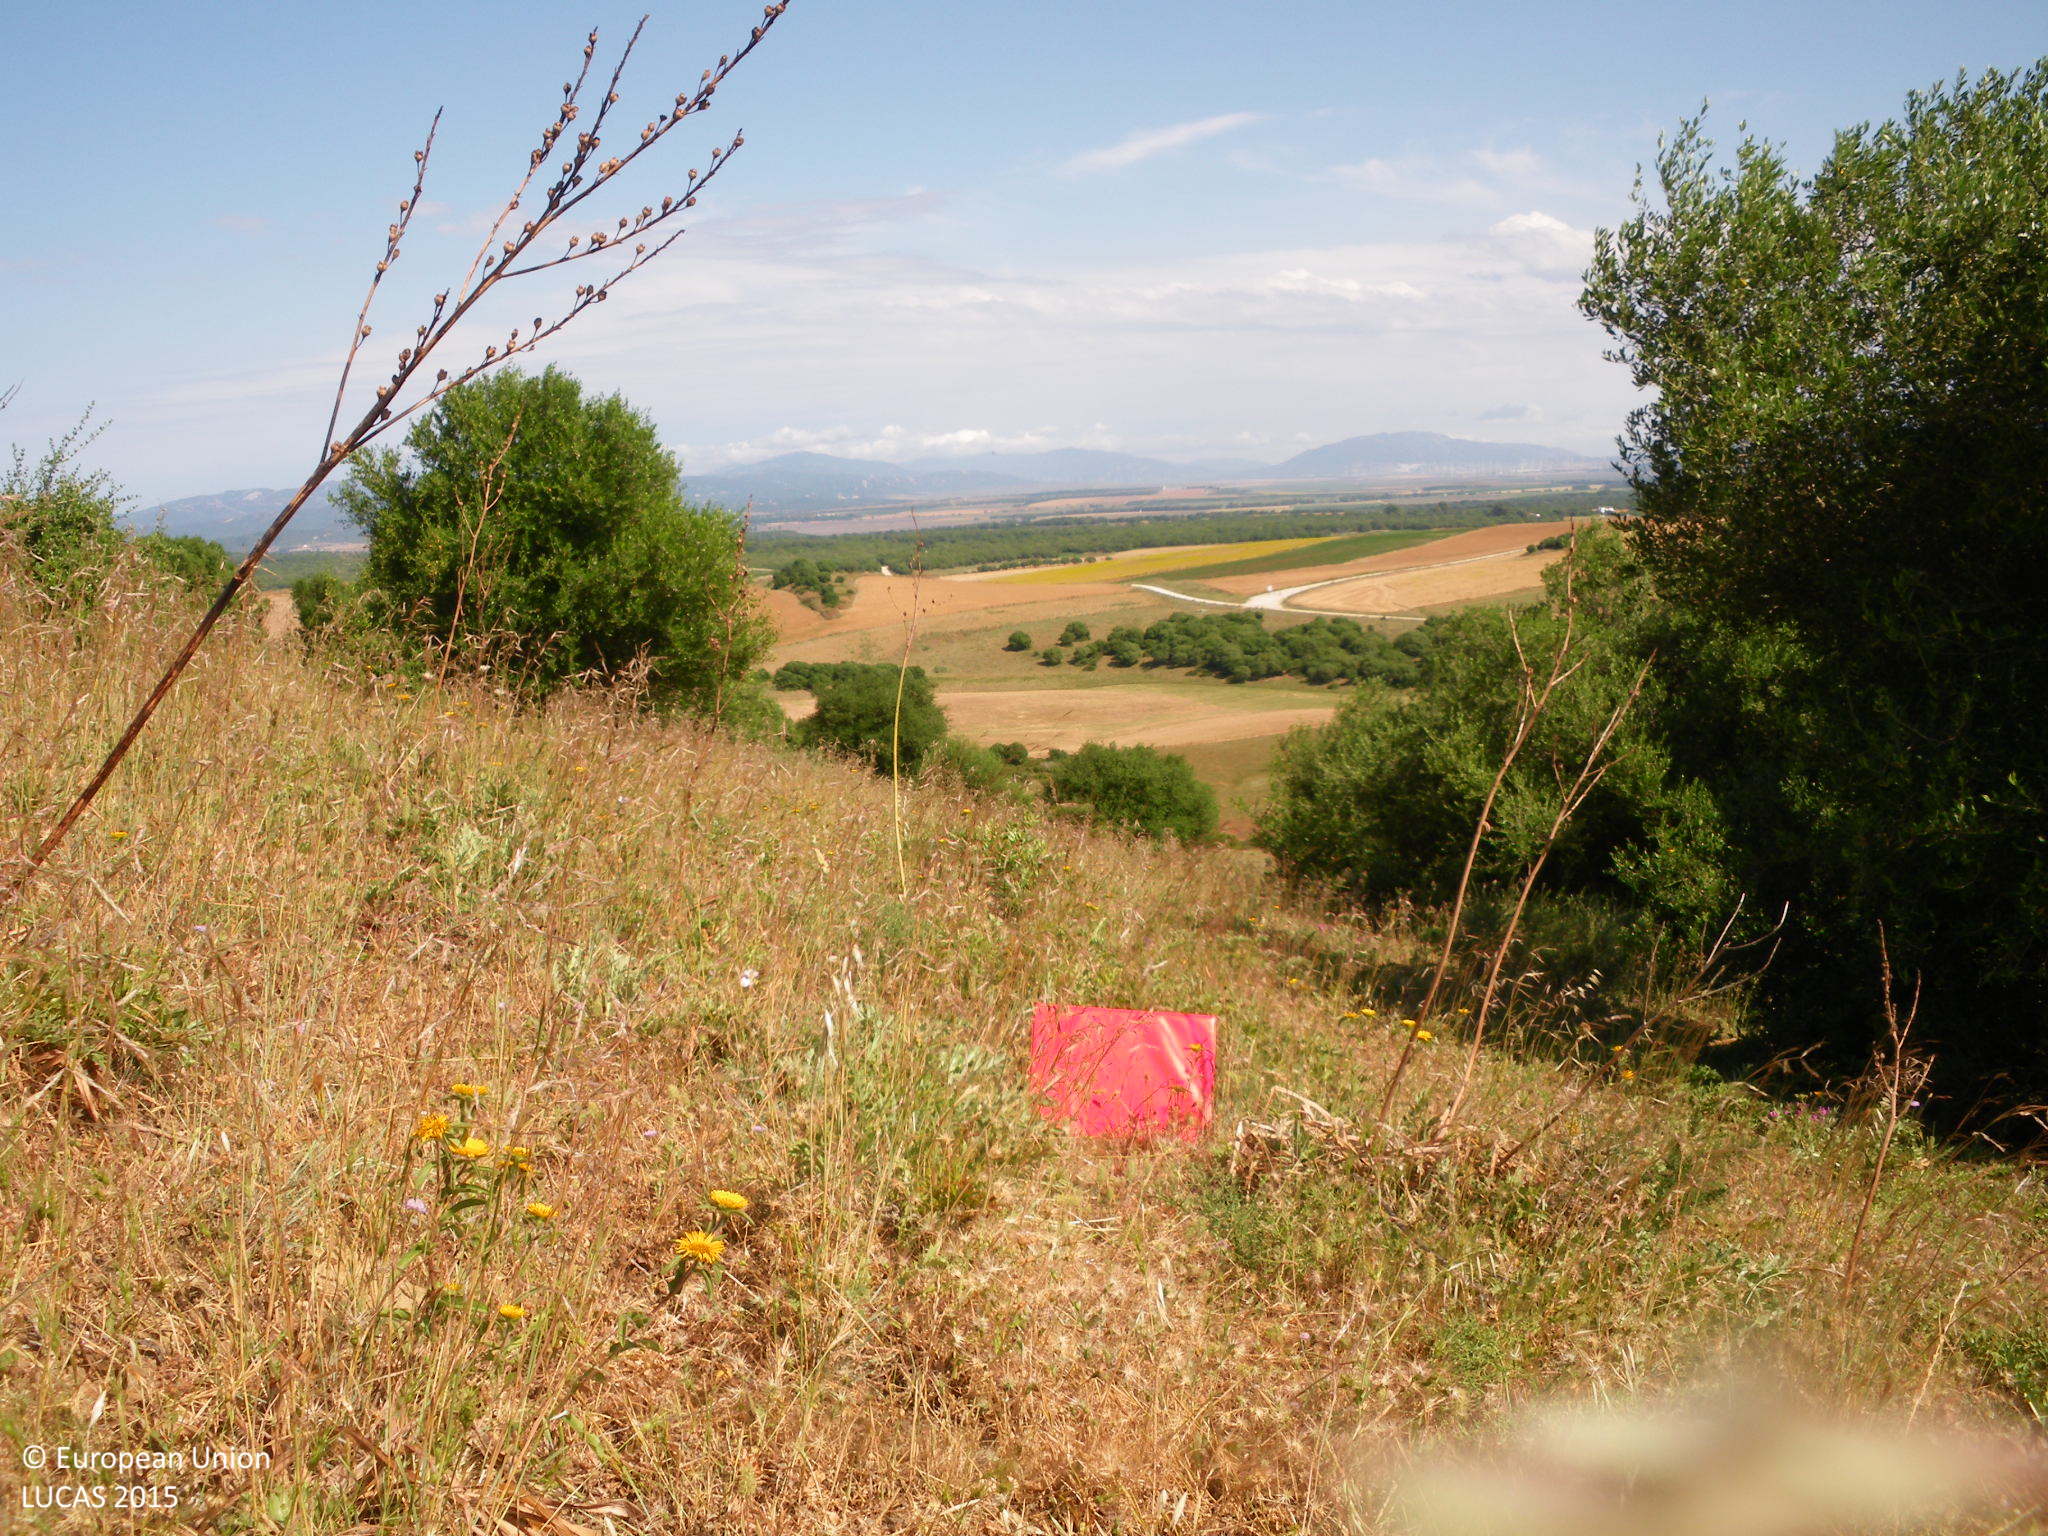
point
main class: Woodland
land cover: Broadleaved woodland
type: broadleaved evergreen forest
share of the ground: 10 - 25 %
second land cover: Grassland without tree/shrub cover
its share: > 75 %
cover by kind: herbaceous plants 80 %, broadleaved forest trees 10 %, shrubs 5 %, unconsolidated bare surface 5 %
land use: Forestry
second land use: Agriculture (excluding fallow land and kitchen gardens)
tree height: < 5 m
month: May
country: ES
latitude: 36.3449
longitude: -5.9016
